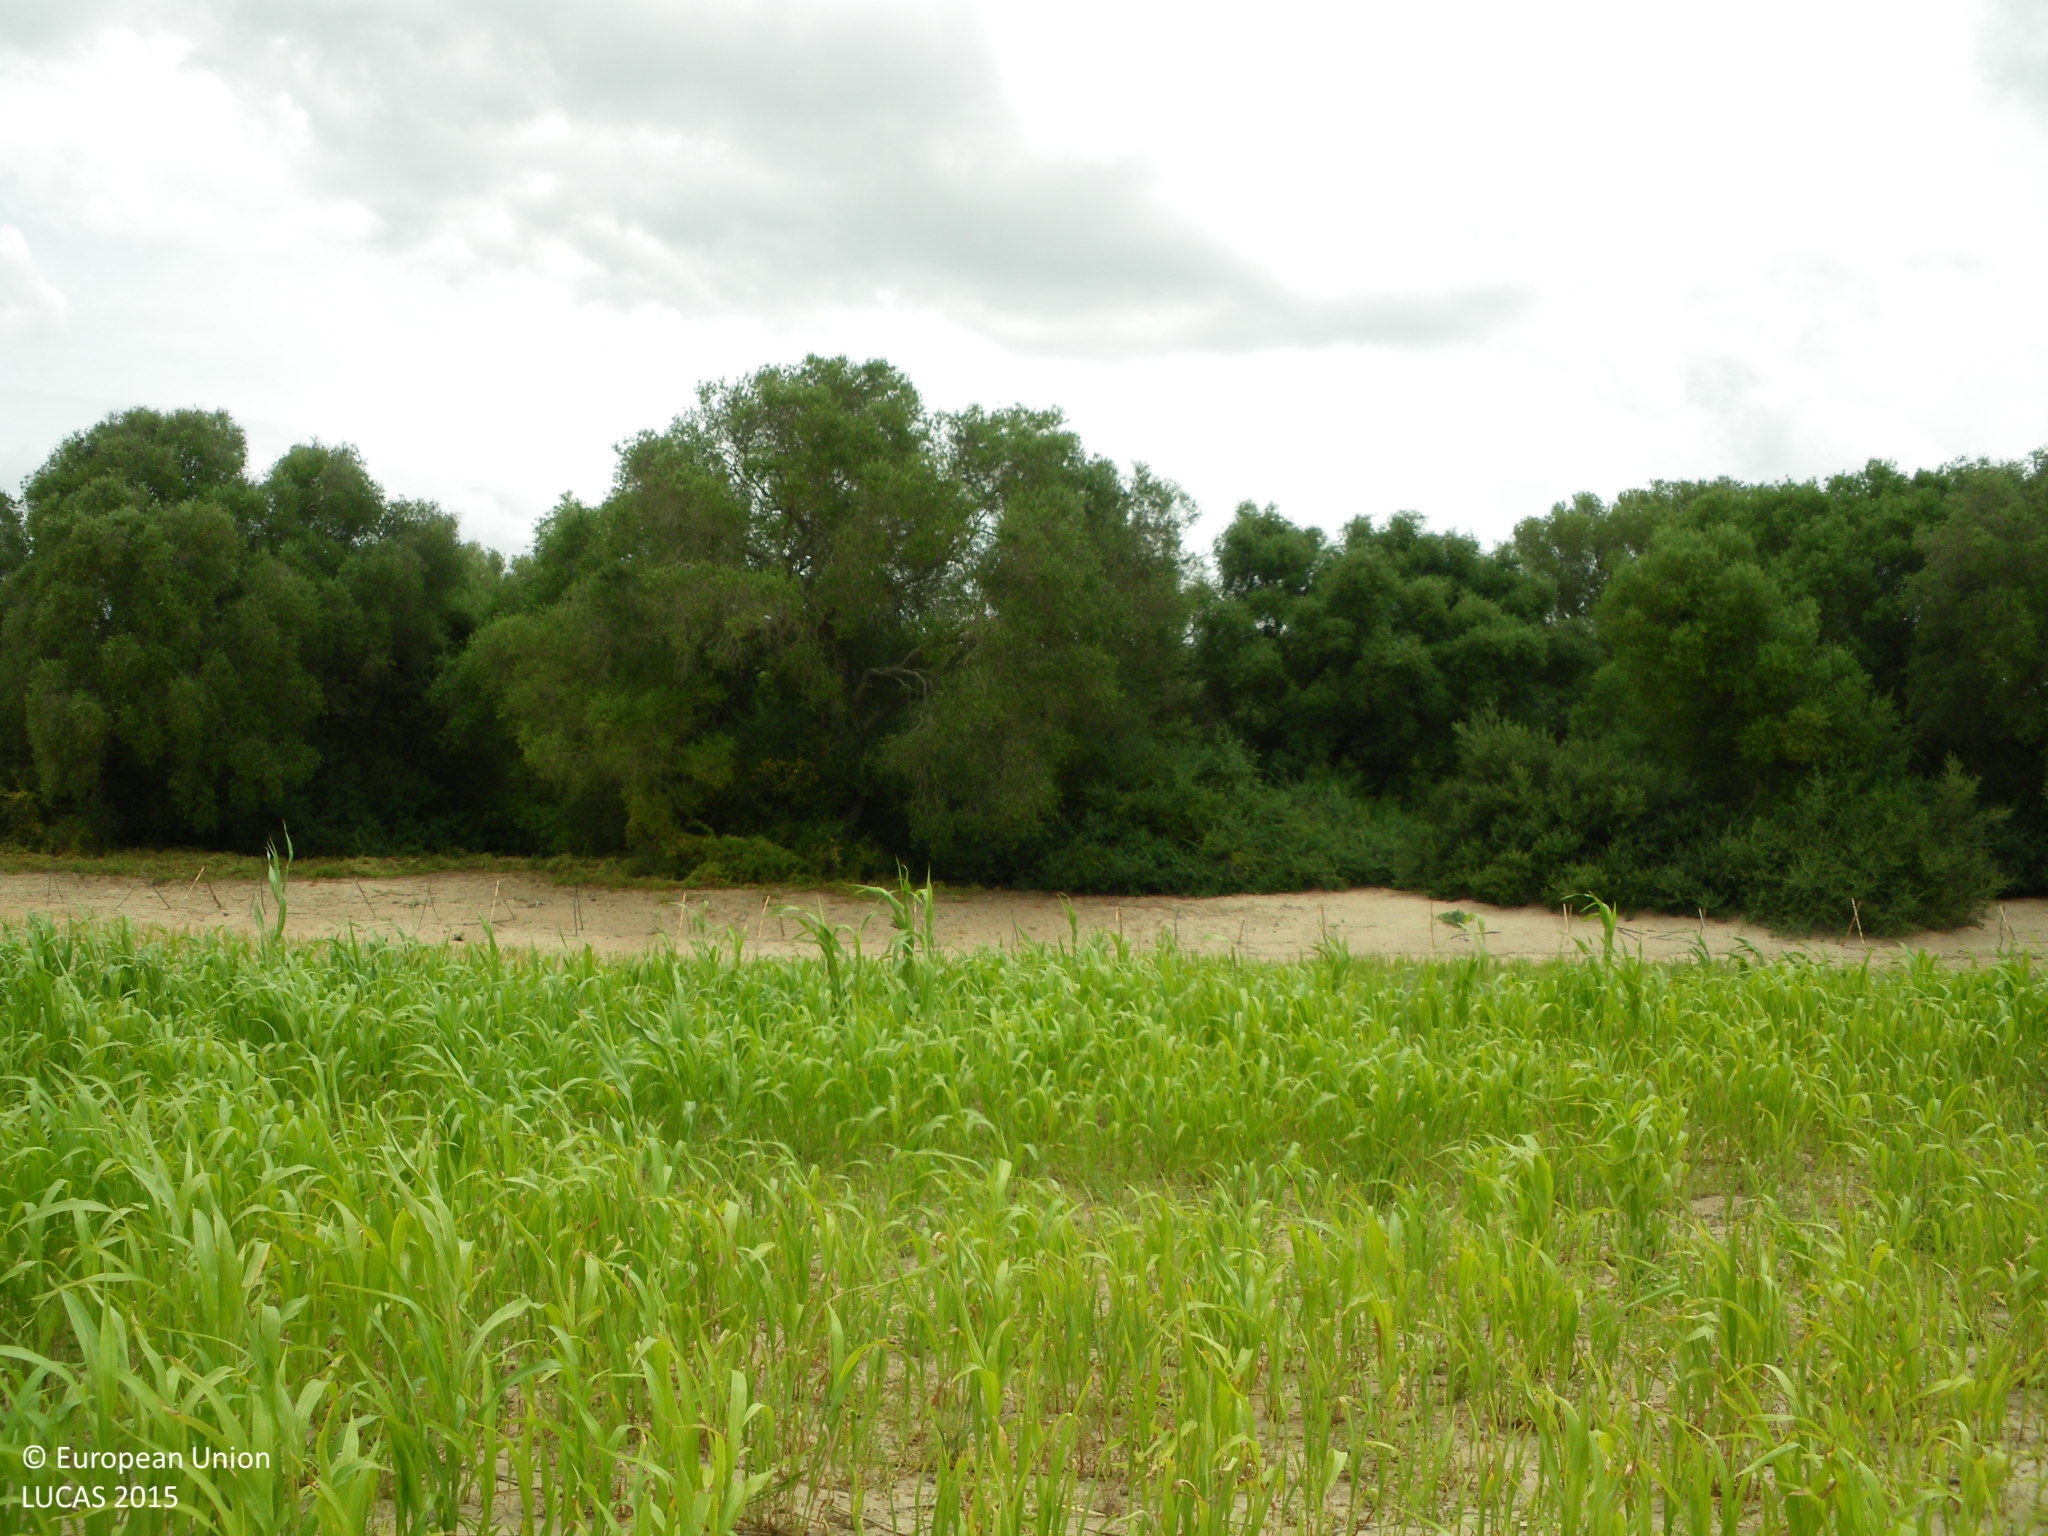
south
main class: Cropland
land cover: Other cereals
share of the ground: < 10 %
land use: Agriculture (excluding fallow land and kitchen gardens)
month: June
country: ES
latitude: 36.3309
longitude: -5.8758
